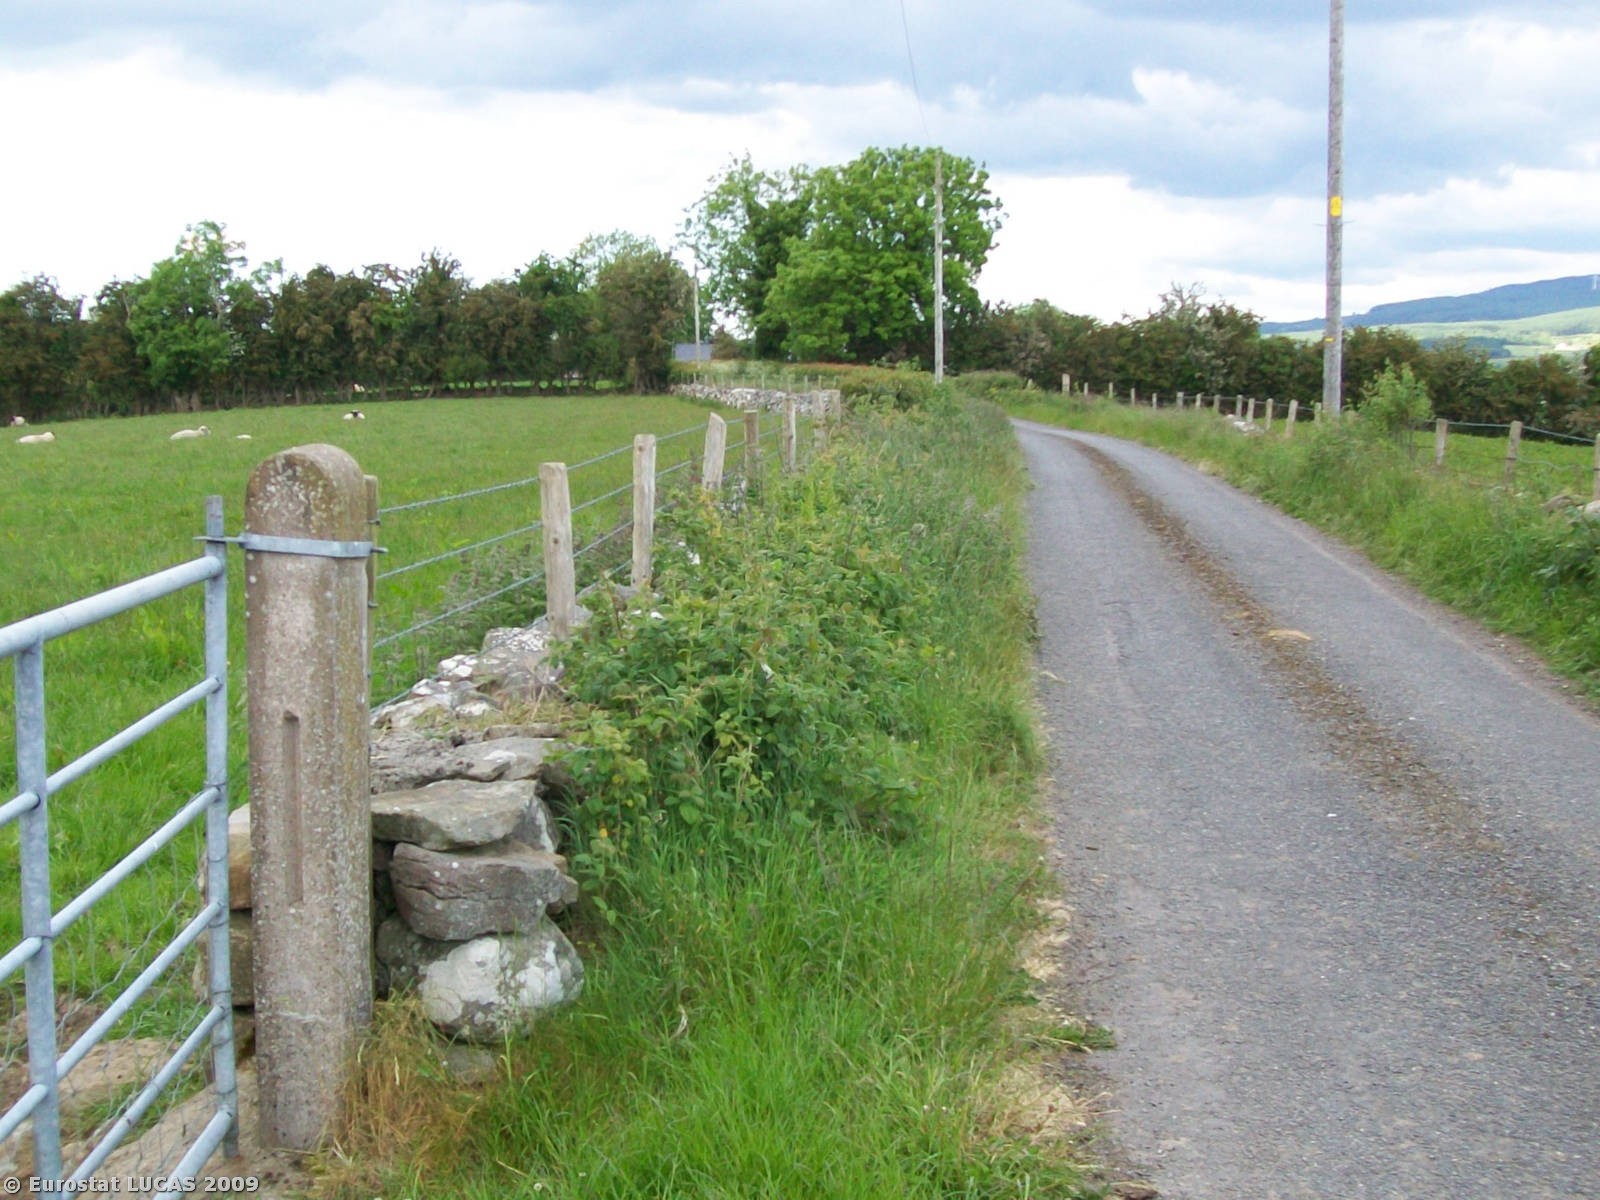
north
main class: Grassland
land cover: Grassland without tree/shrub cover
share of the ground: > 75 %
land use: Agriculture (excluding fallow land and kitchen gardens)
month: June
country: GB
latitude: 54.6393
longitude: -7.4931
